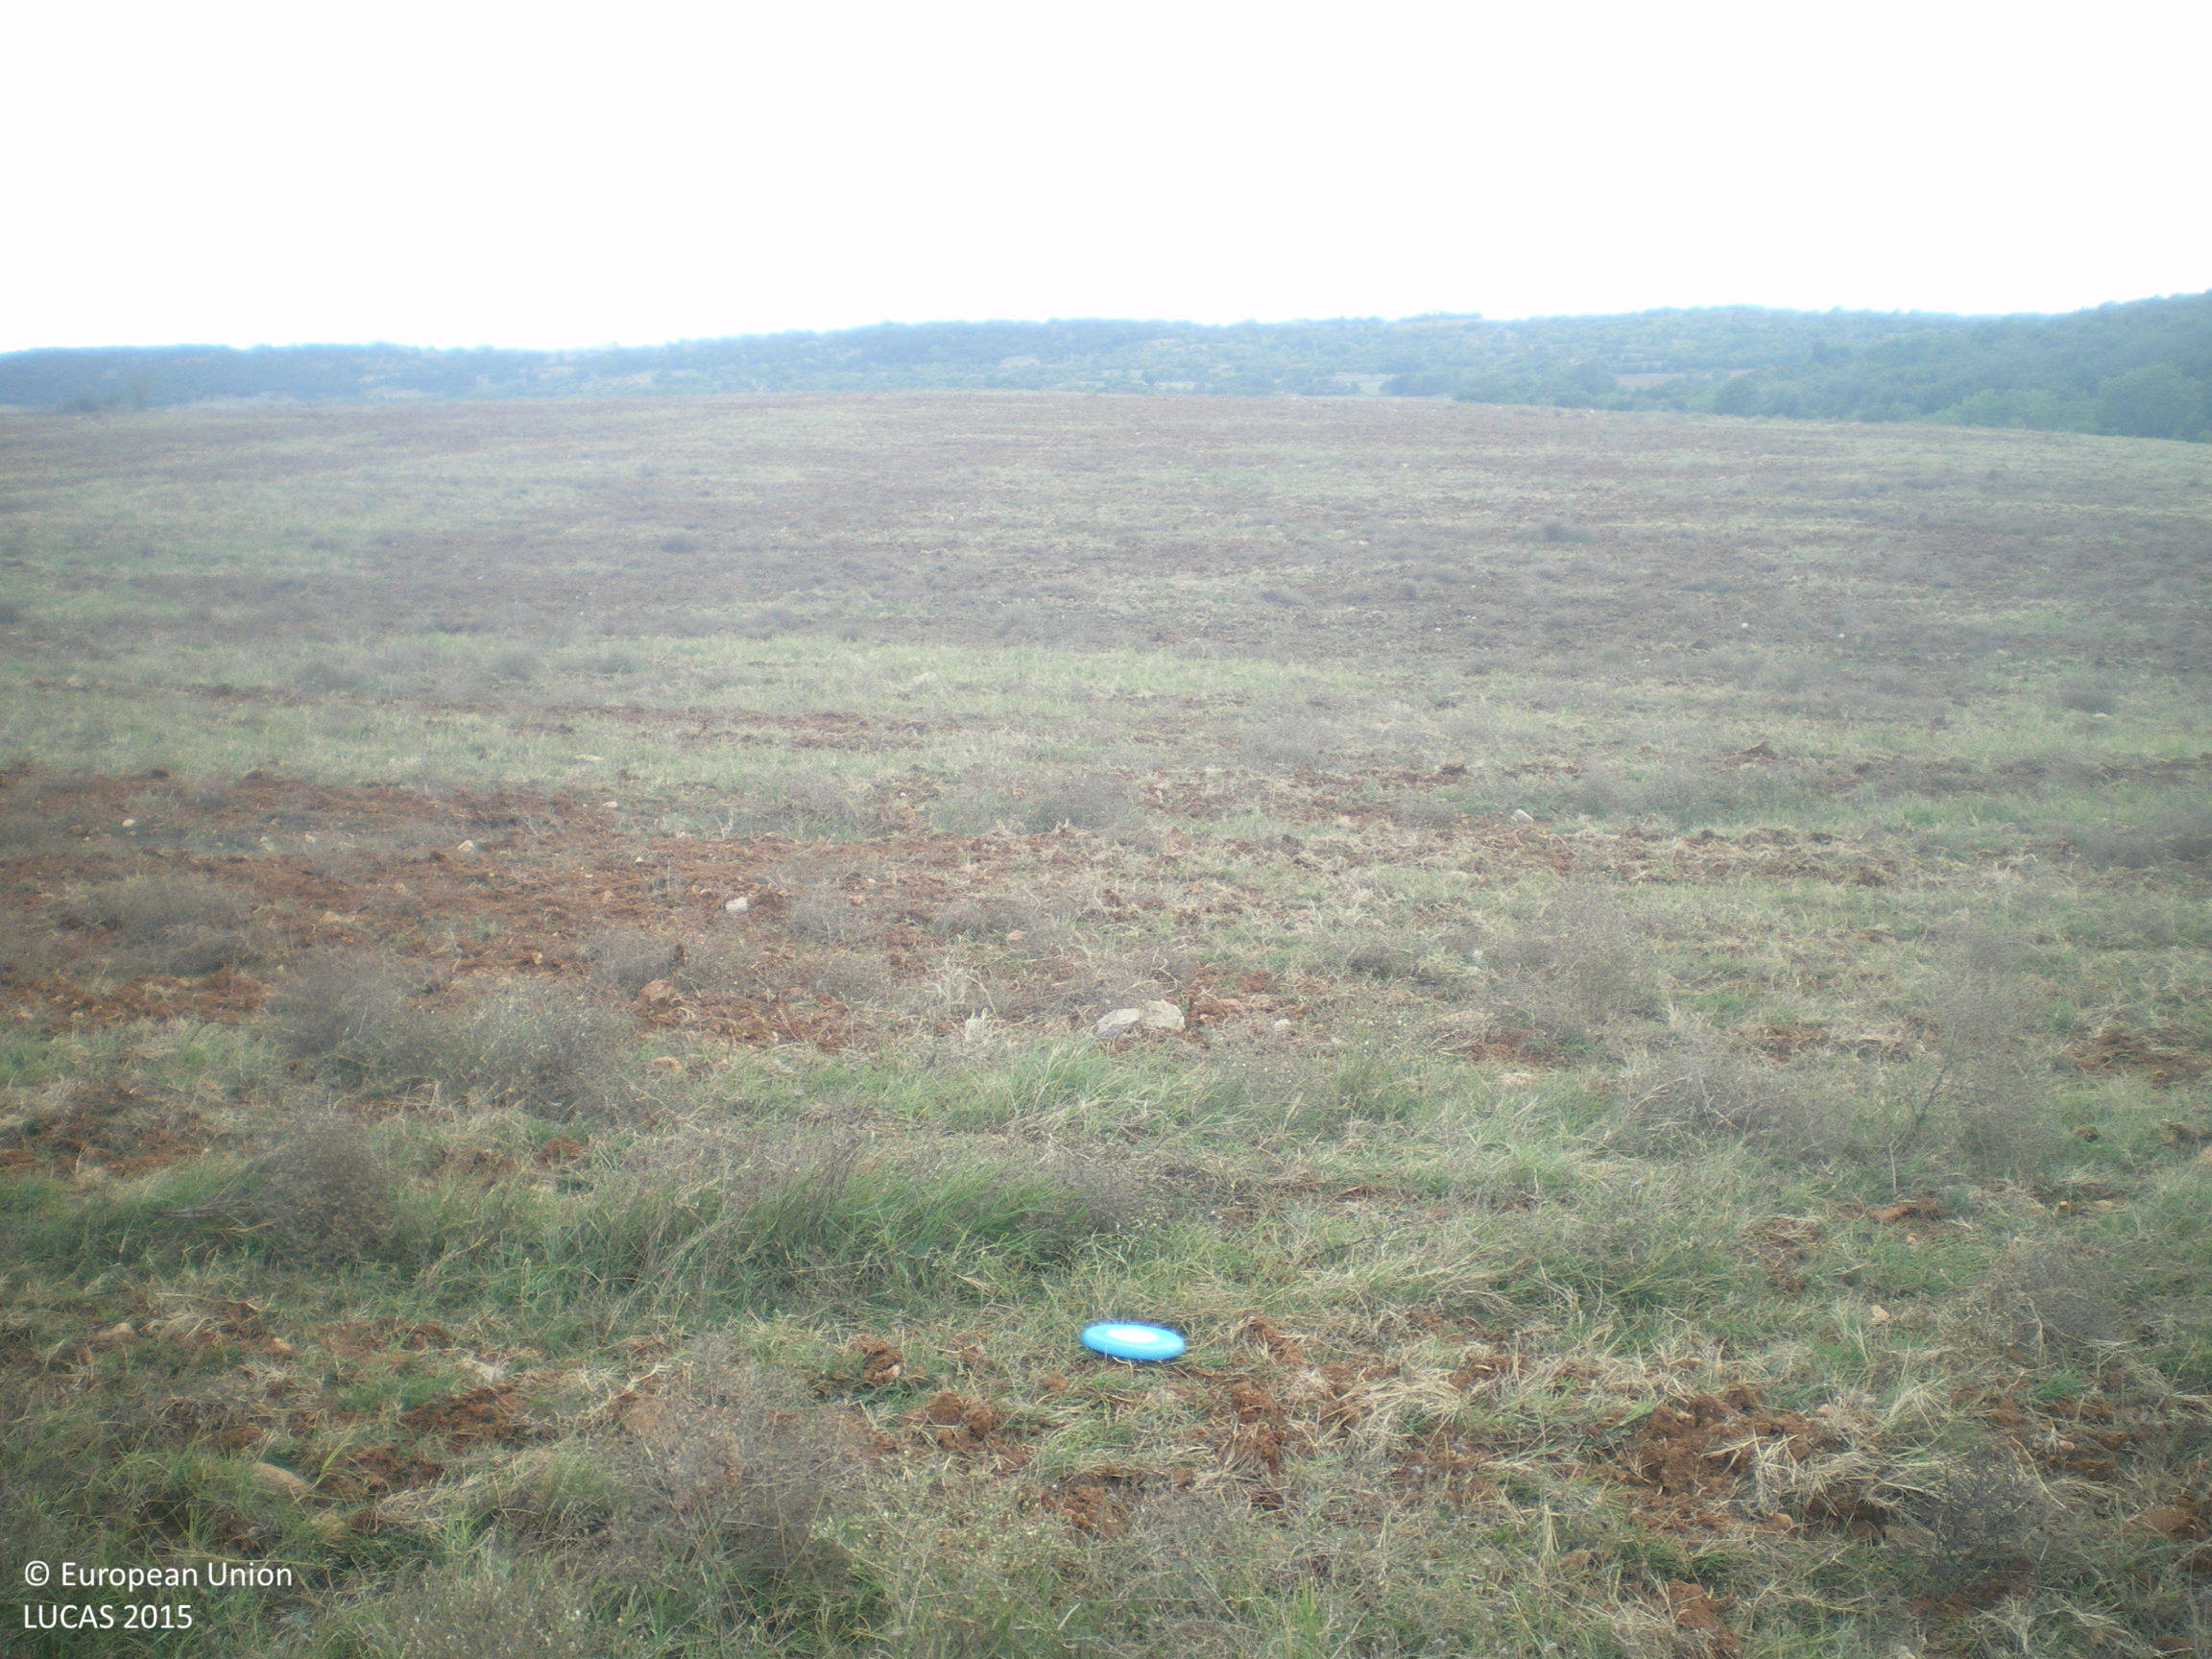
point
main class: Grassland
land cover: Spontaneously vegetated surfaces
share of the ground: > 75 %
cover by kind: herbaceous plants 95 %, unconsolidated bare surface 5 %
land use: Fallow land
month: September
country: BG
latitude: 42.0742
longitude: 26.0925
